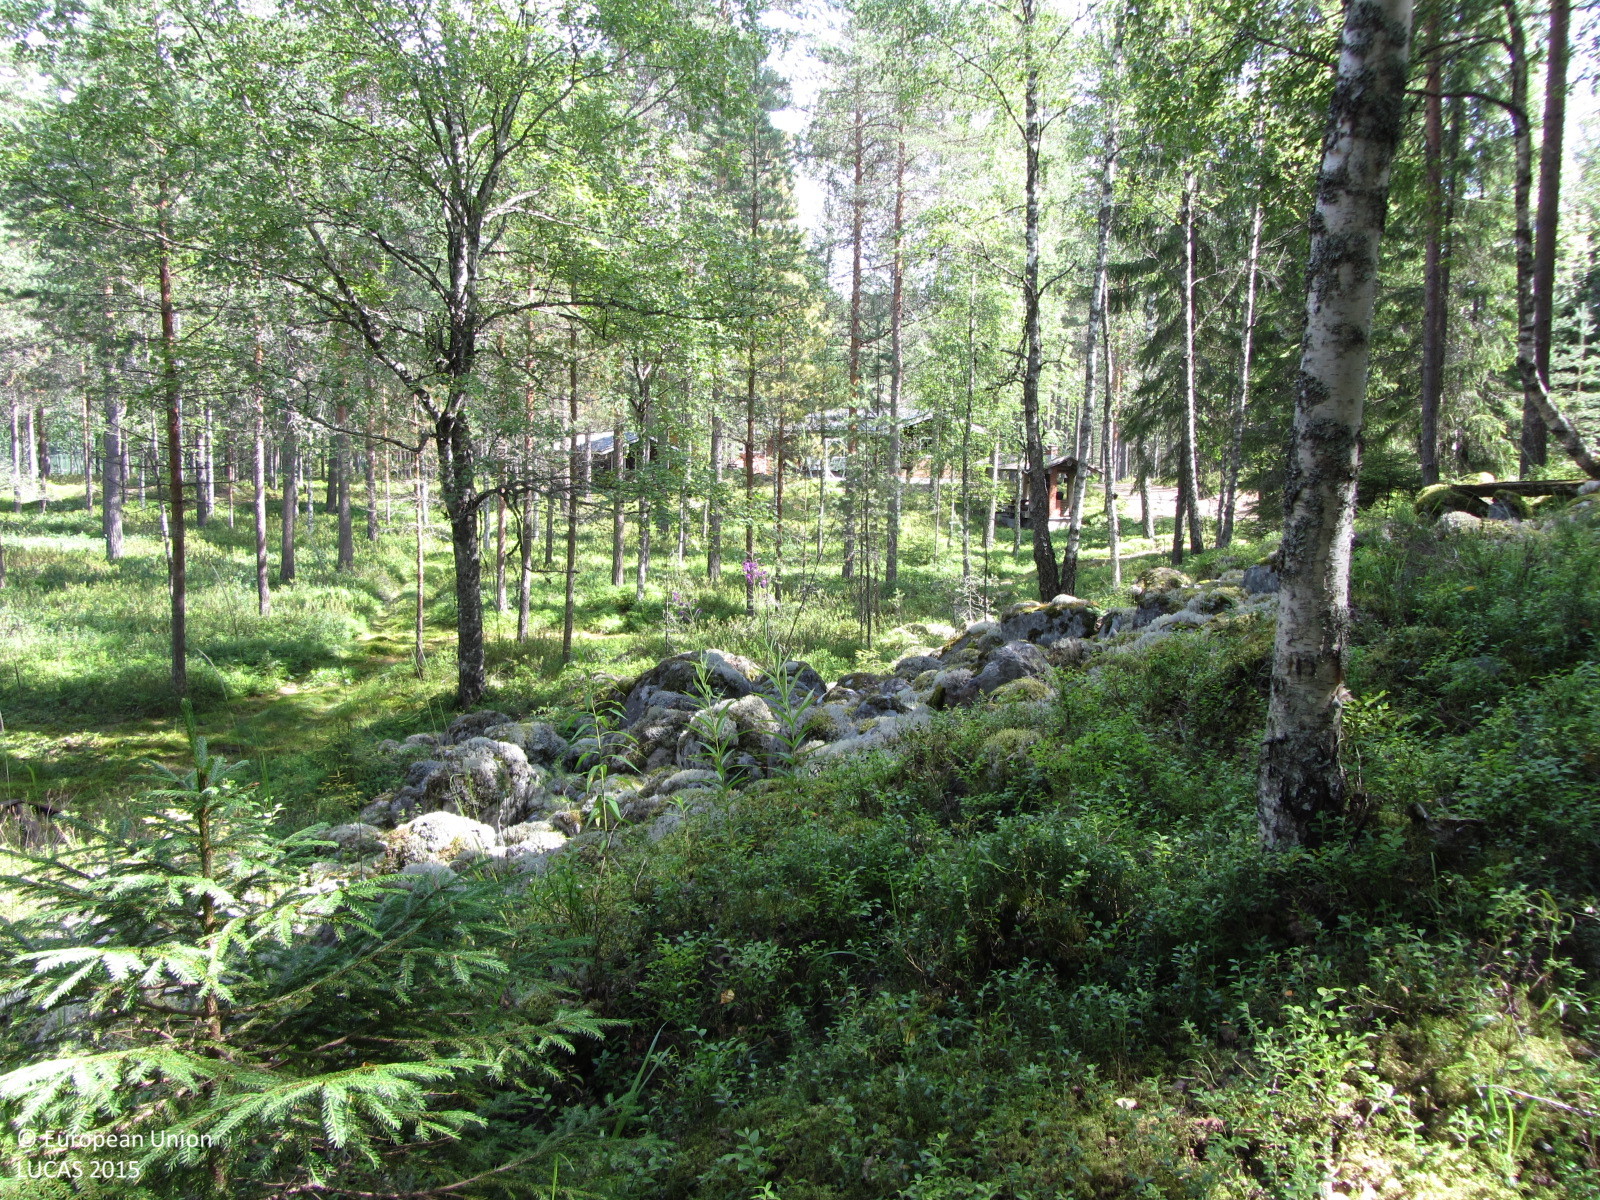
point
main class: Woodland
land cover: Pine dominated mixed woodland
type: boreal forest
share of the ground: 50 - 75 %
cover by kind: coniferous forest trees 30 %, broadleaved forest trees 30 %, shrubs 20 %, lichens and mosses 15 %, unconsolidated bare surface 5 %
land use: Forestry
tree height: > 5 m
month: July
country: FI
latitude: 60.6311
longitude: 24.3790
